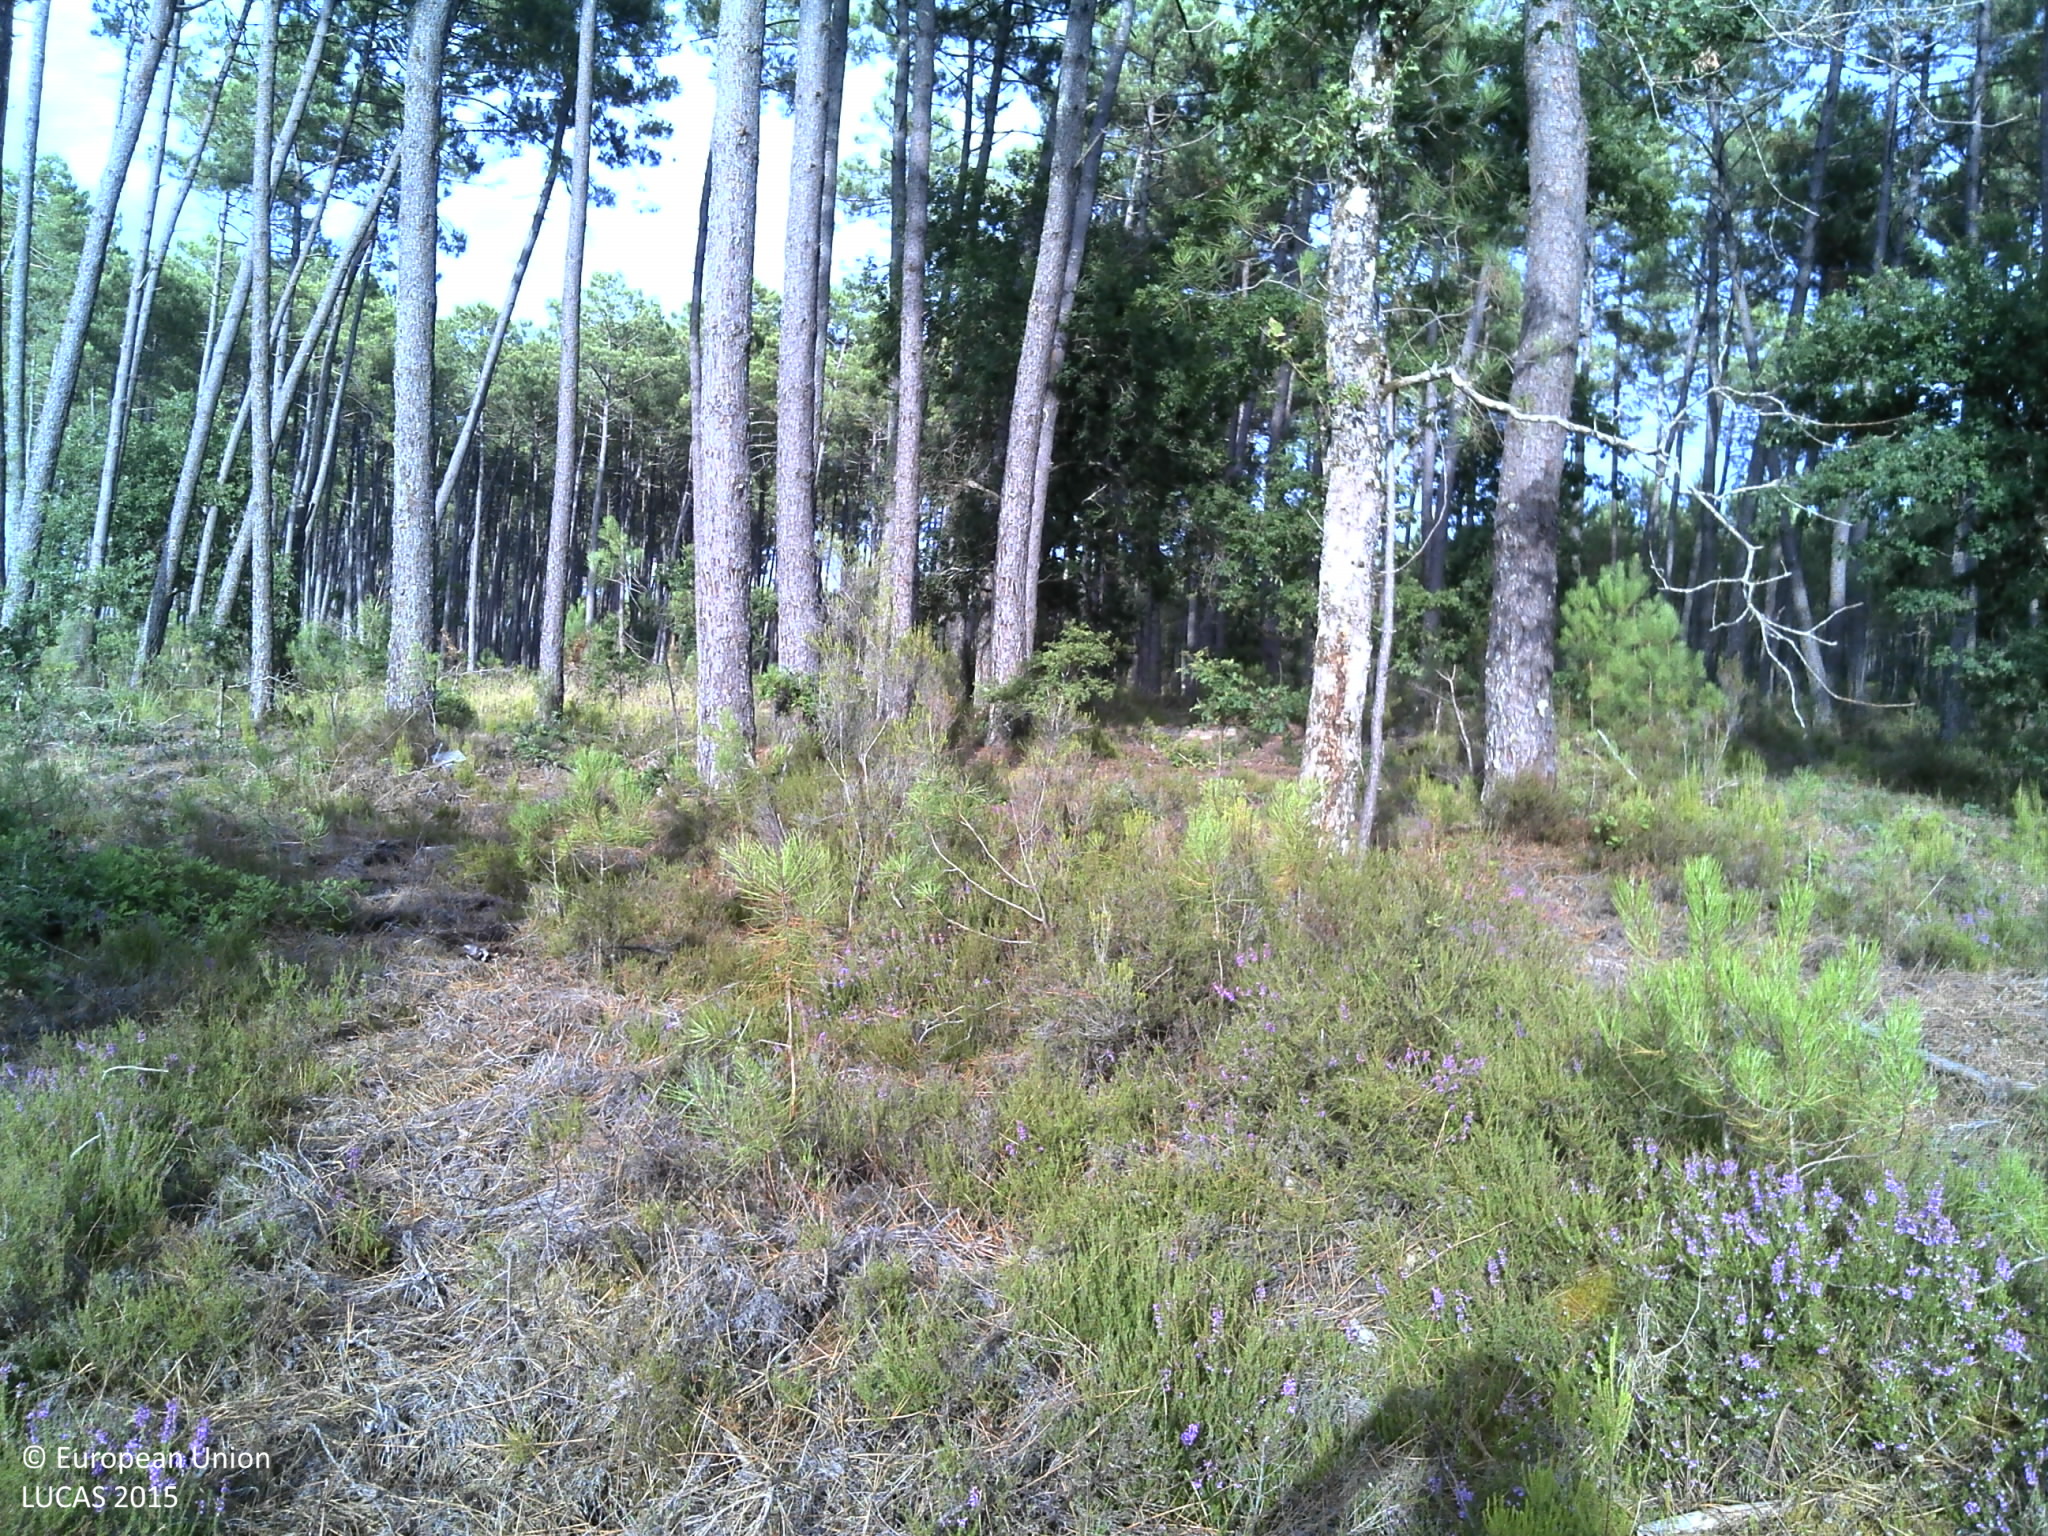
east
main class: Woodland
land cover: Pine dominated coniferous woodland
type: coniferous forest of the mediterranean region
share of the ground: 50 - 75 %
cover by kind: coniferous forest trees 60 %, shrubs 30 %, herbaceous plants 5 %, lichens and mosses 5 %
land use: Forestry
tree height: > 5 m
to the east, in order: Pine dominated coniferous woodland; Paved roads, cycling and walking lanes; Pine dominated coniferous woodland; Tracks; Pine dominated coniferous woodland
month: July
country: FR
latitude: 44.5021
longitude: -0.8990
